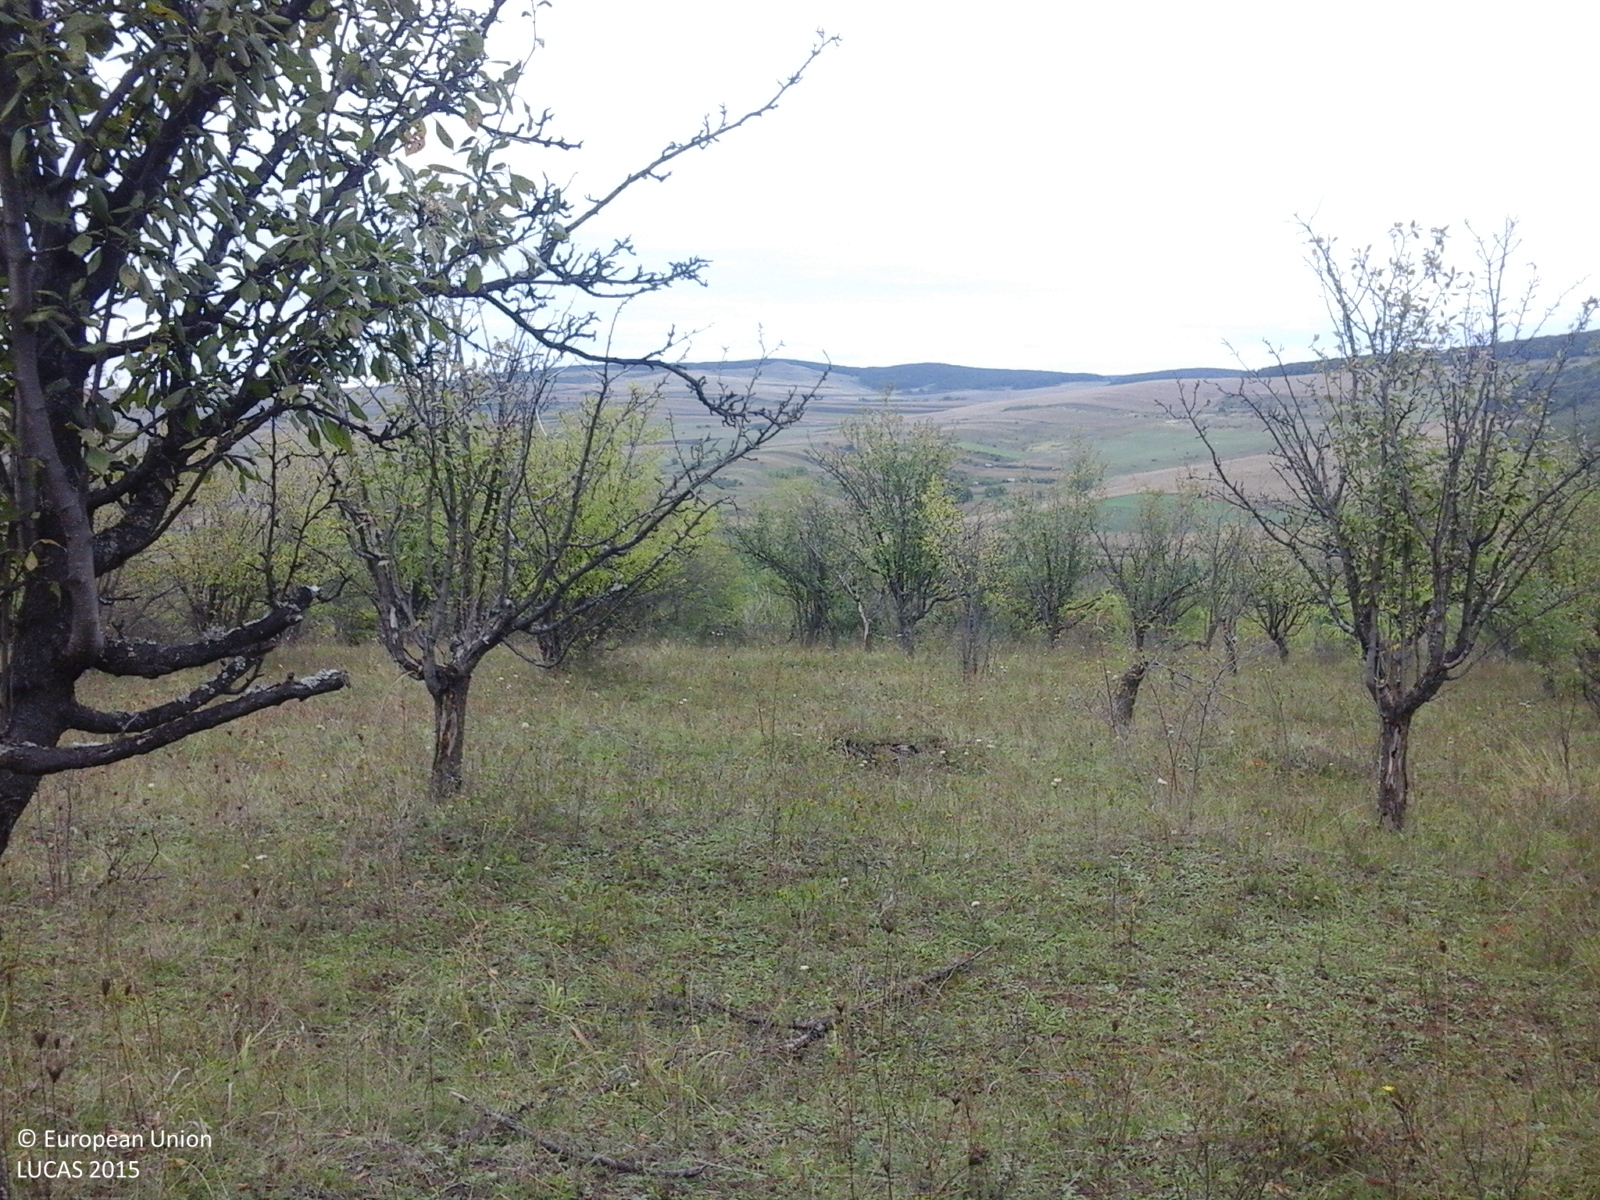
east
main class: Cropland
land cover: Other fruit trees and berries
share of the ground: 50 - 75 %
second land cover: Grassland without tree/shrub cover
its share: > 75 %
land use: Agriculture (excluding fallow land and kitchen gardens)
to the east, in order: Other fruit trees and berries; Grassland without tree/shrub cover; Shrubland with sparse tree cover; Other fruit trees and berries
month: September
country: RO
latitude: 45.9779
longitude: 23.6848
